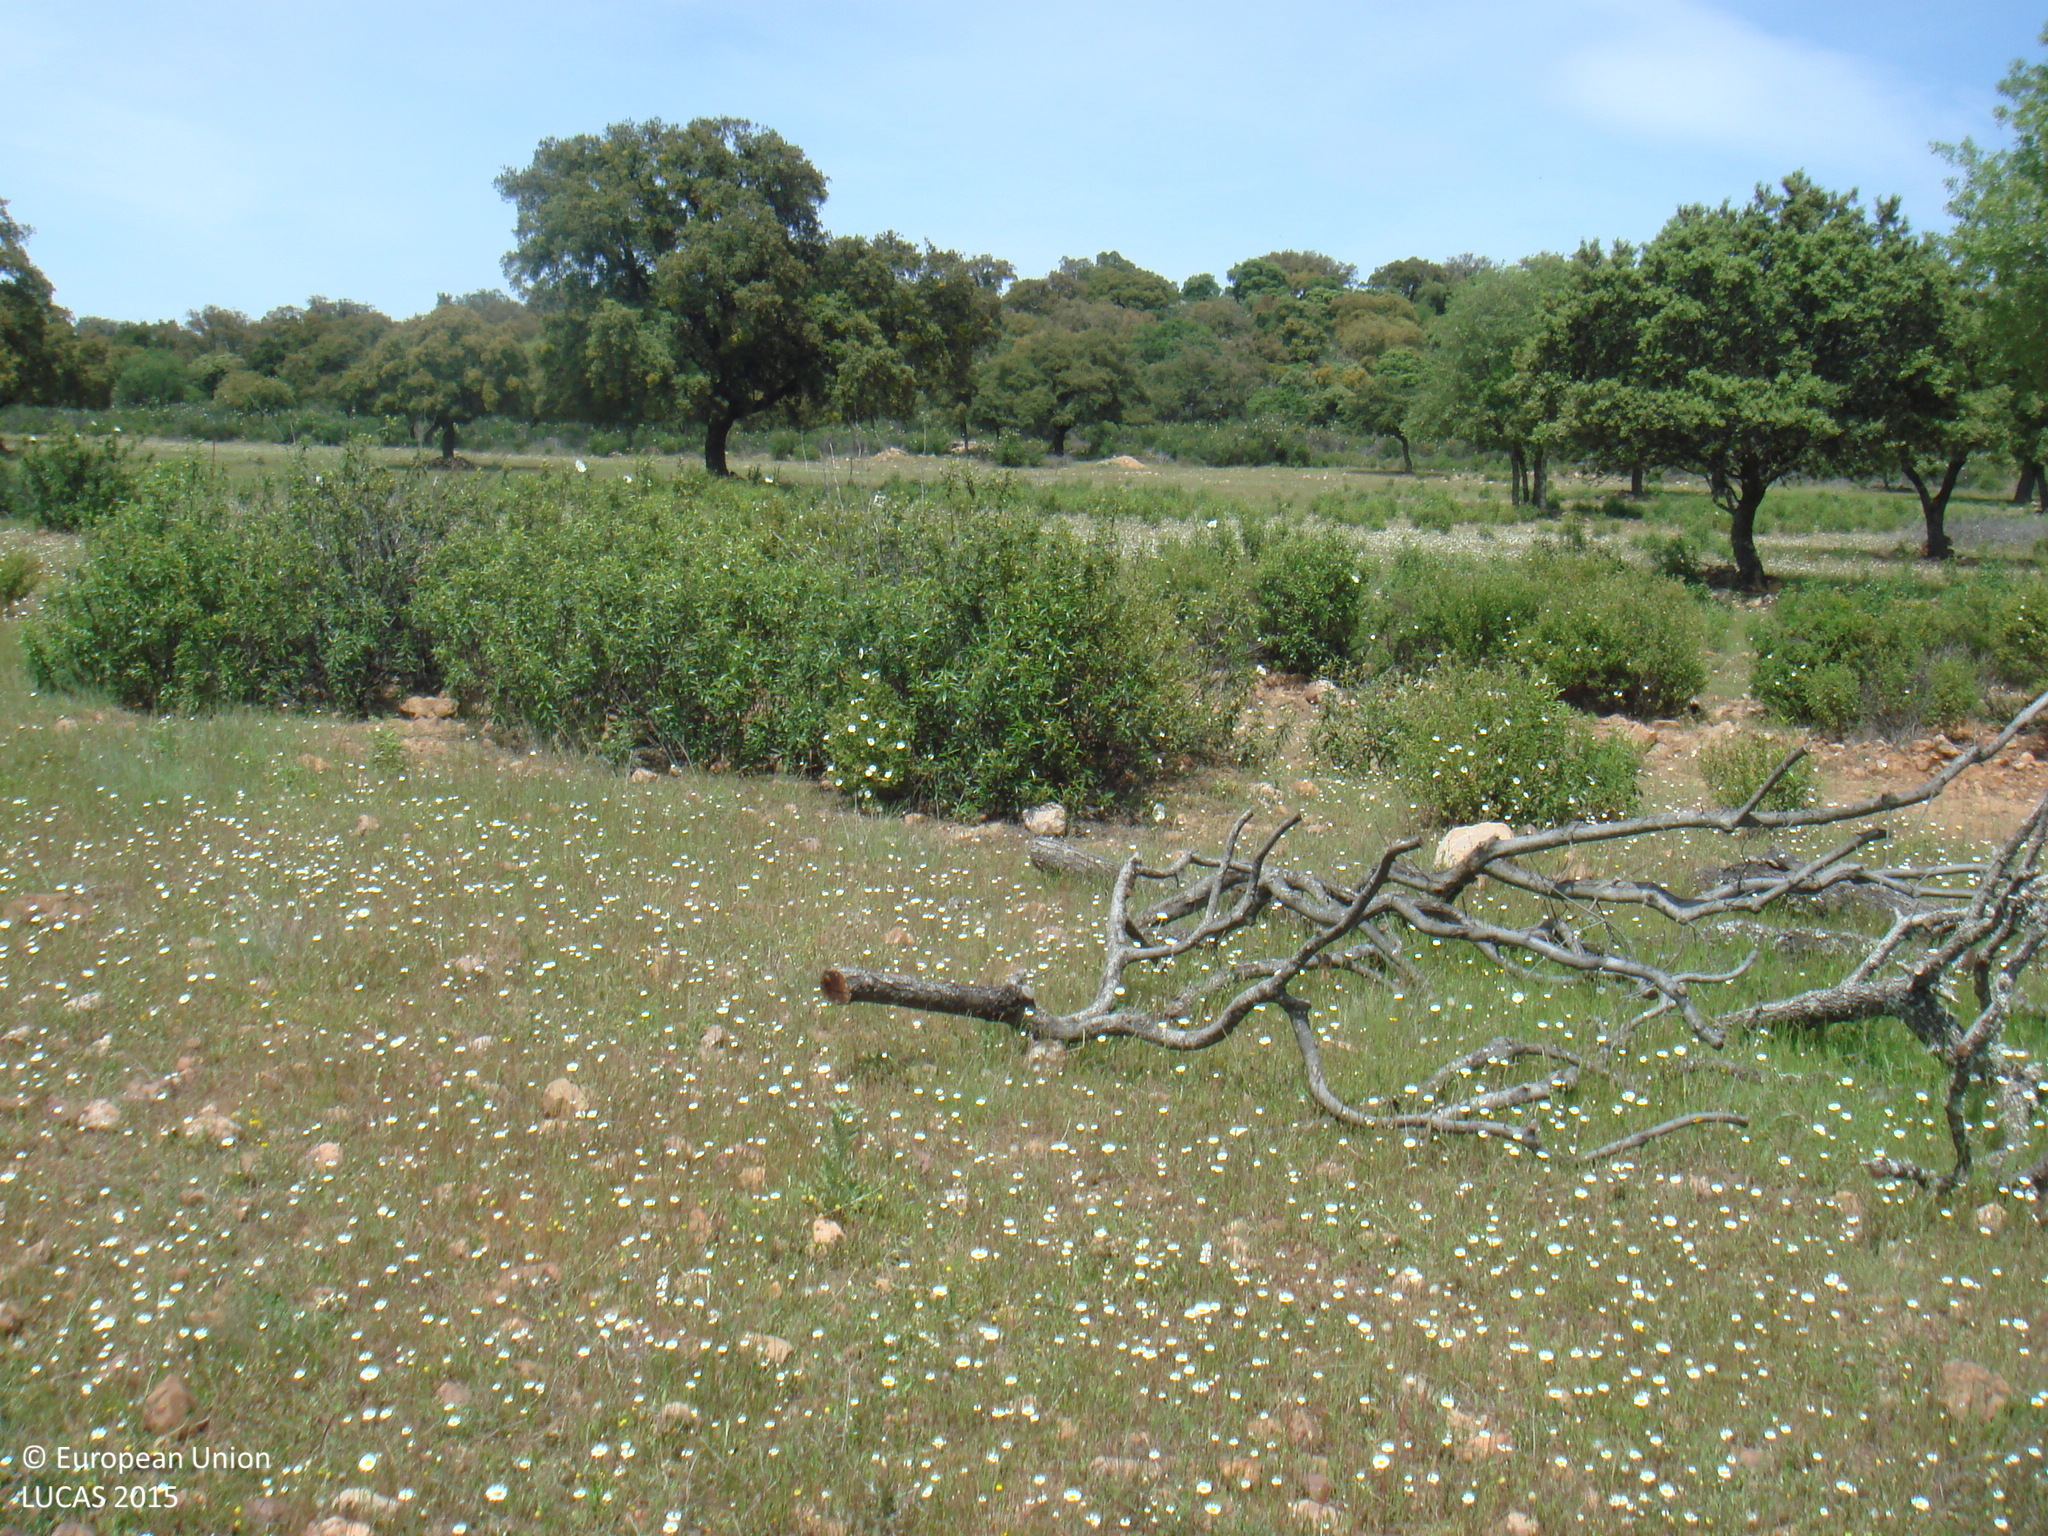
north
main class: Grassland
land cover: Spontaneously vegetated surfaces
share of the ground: > 75 %
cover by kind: herbaceous plants 75 %, unconsolidated bare surface 20 %, shrubs 5 %
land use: Agriculture (excluding fallow land and kitchen gardens)
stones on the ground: 10 - 25 %
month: May
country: ES
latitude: 38.2852
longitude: -5.0819
